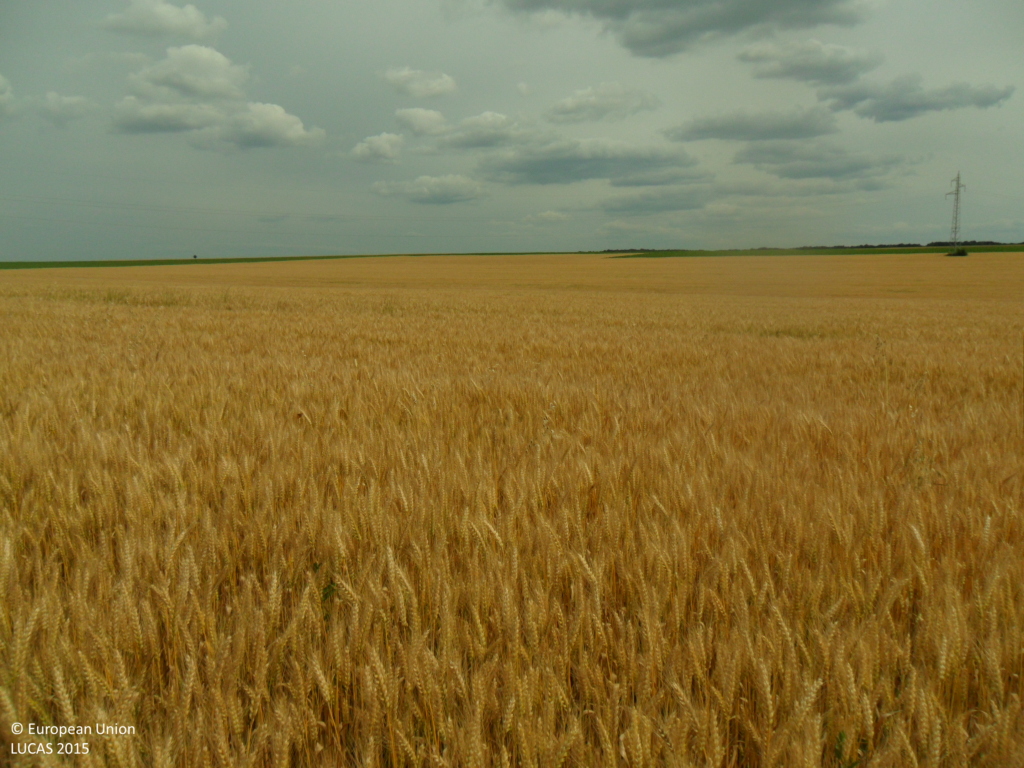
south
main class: Cropland
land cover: Common wheat
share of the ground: > 75 %
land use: Agriculture (excluding fallow land and kitchen gardens)
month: June
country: BG
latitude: 43.6767
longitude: 26.7463
